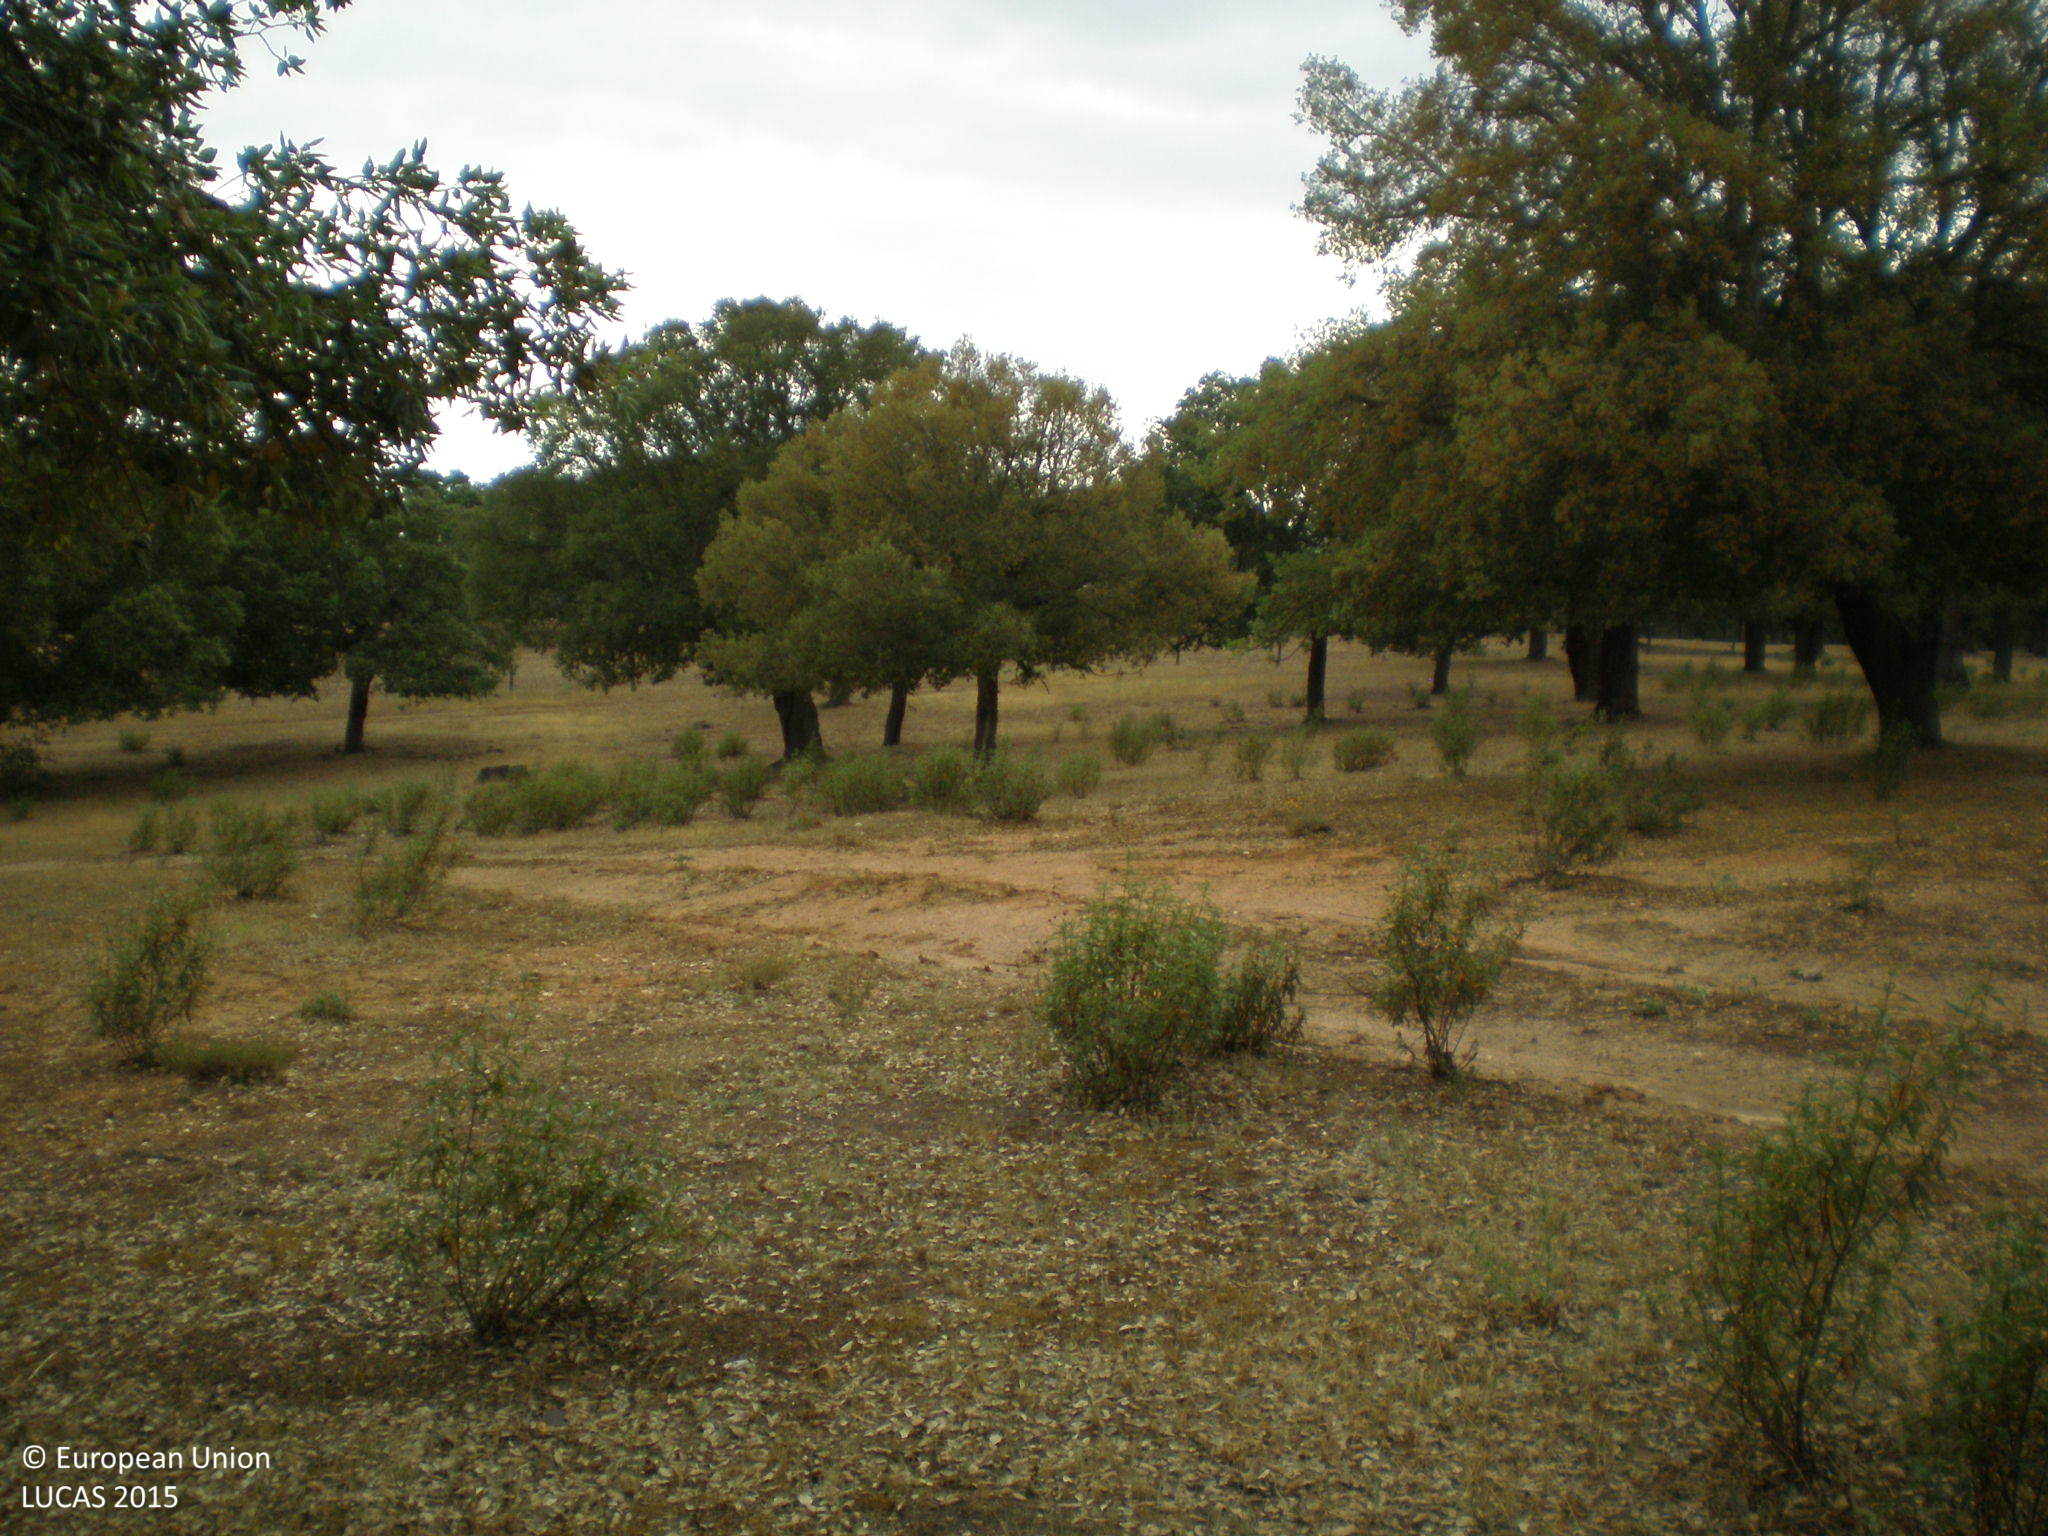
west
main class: Woodland
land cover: Broadleaved woodland
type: broadleaved evergreen forest
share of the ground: 25 - 50 %
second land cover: Grassland without tree/shrub cover
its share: 50 - 75 %
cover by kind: herbaceous plants 55 %, broadleaved forest trees 45 %
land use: Forestry
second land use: Agriculture (excluding fallow land and kitchen gardens)
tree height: > 5 m
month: June
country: ES
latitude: 41.1868
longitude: -5.7844
